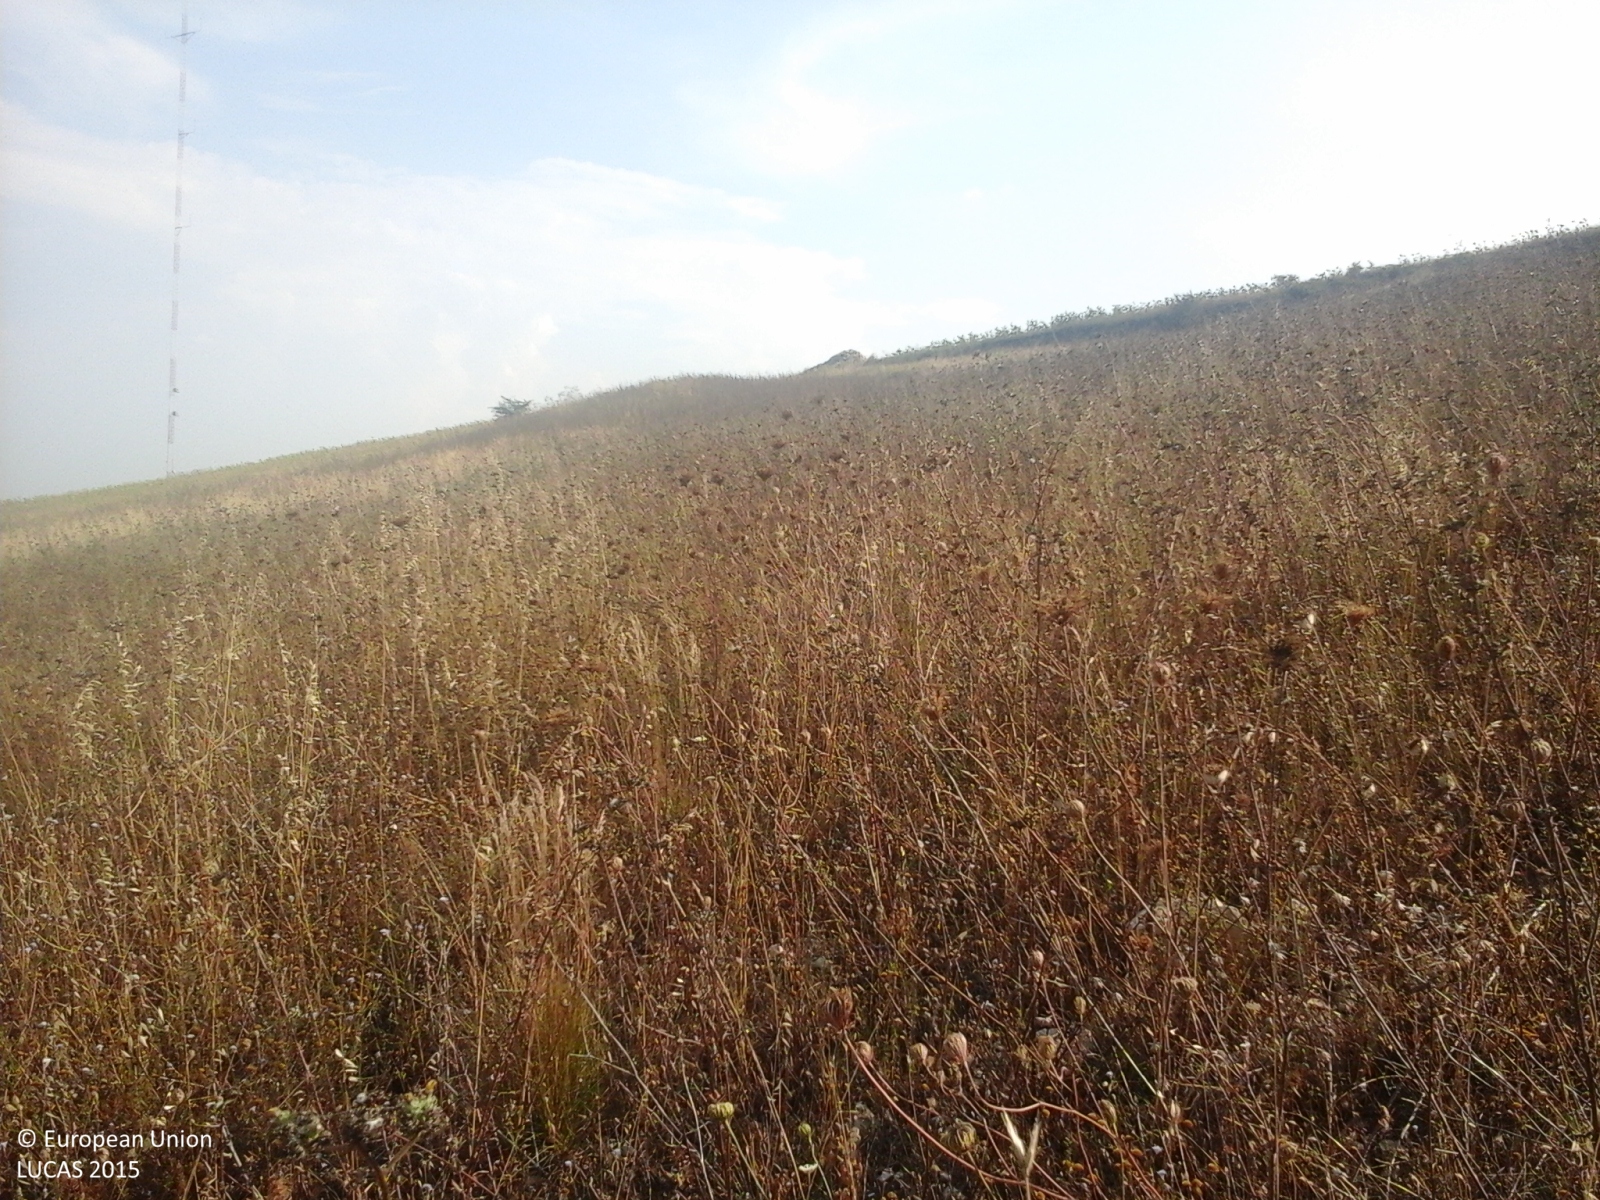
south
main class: Grassland
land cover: Spontaneously vegetated surfaces
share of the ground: > 75 %
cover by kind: herbaceous plants 100 %
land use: Abandoned areas
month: August
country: IT
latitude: 41.3087
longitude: 15.1776
